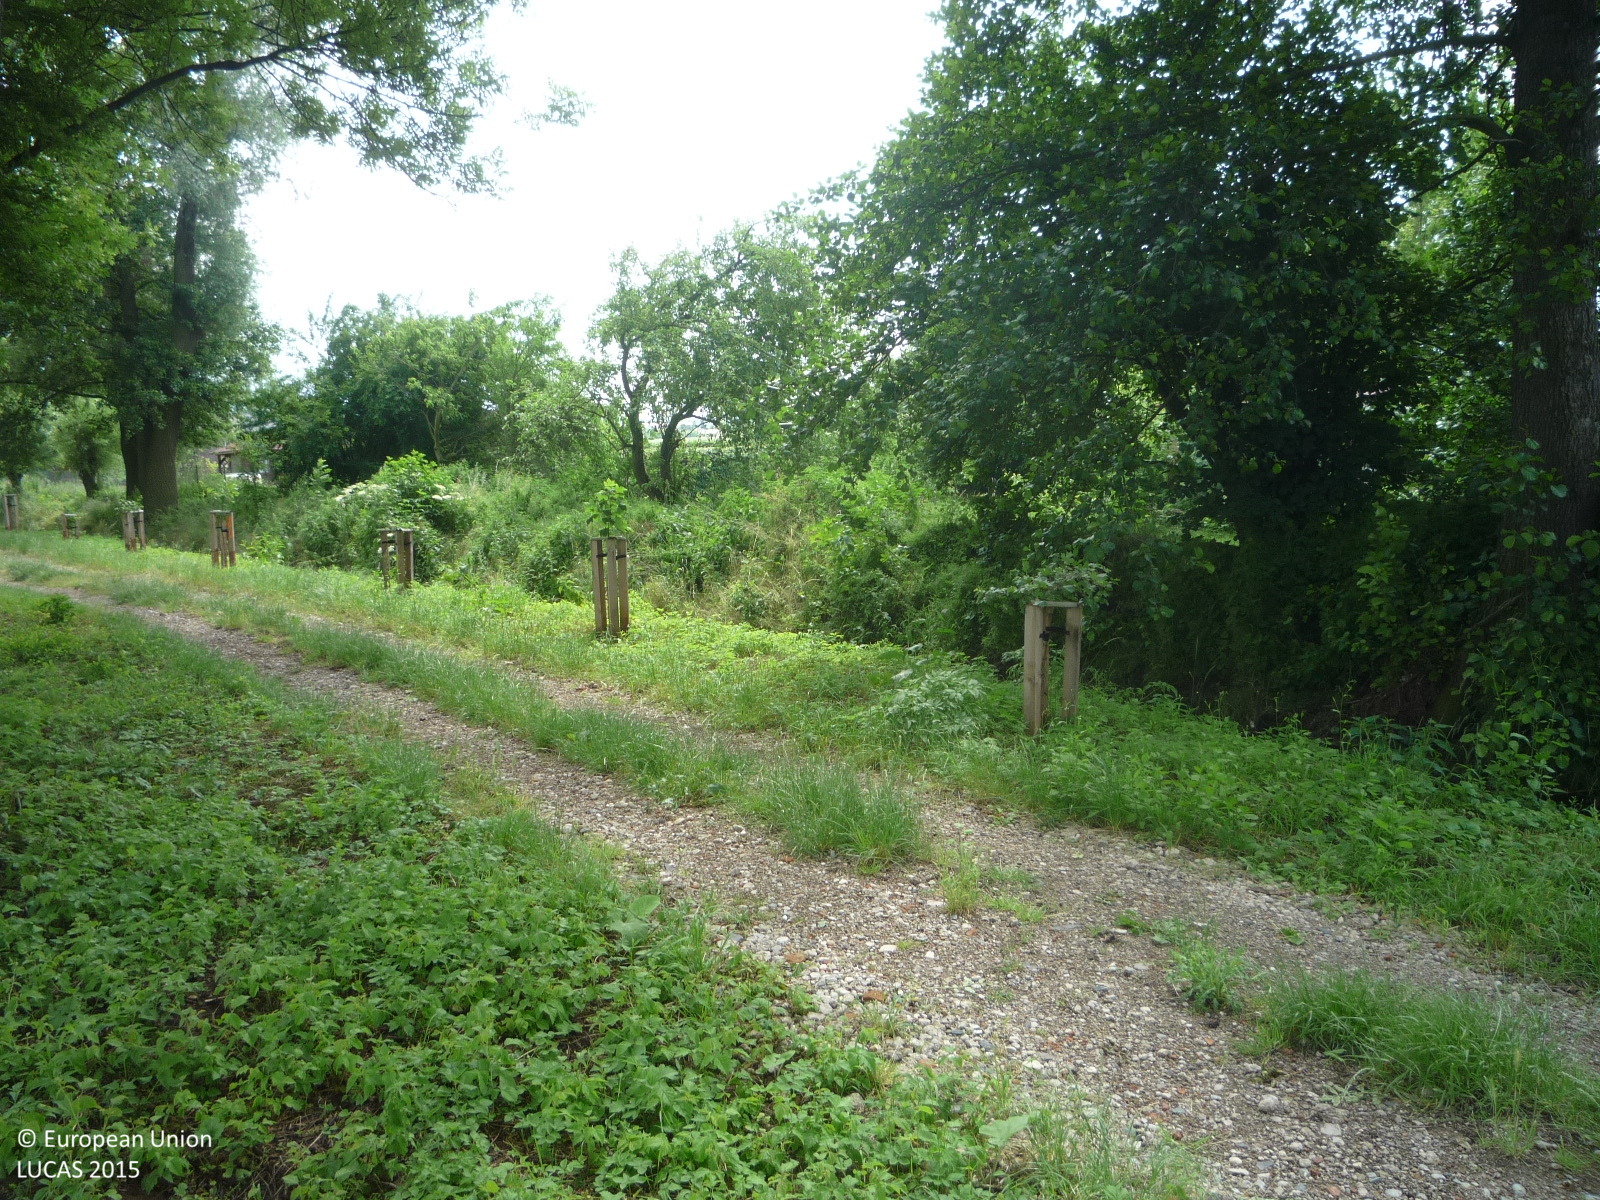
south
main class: Woodland
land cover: Broadleaved woodland
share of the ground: > 75 %
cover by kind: broadleaved forest trees 85 %, herbaceous plants 15 %
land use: Forestry
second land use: Amenities, museums, leisure
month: June
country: CZ
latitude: 50.3707
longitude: 13.8673
